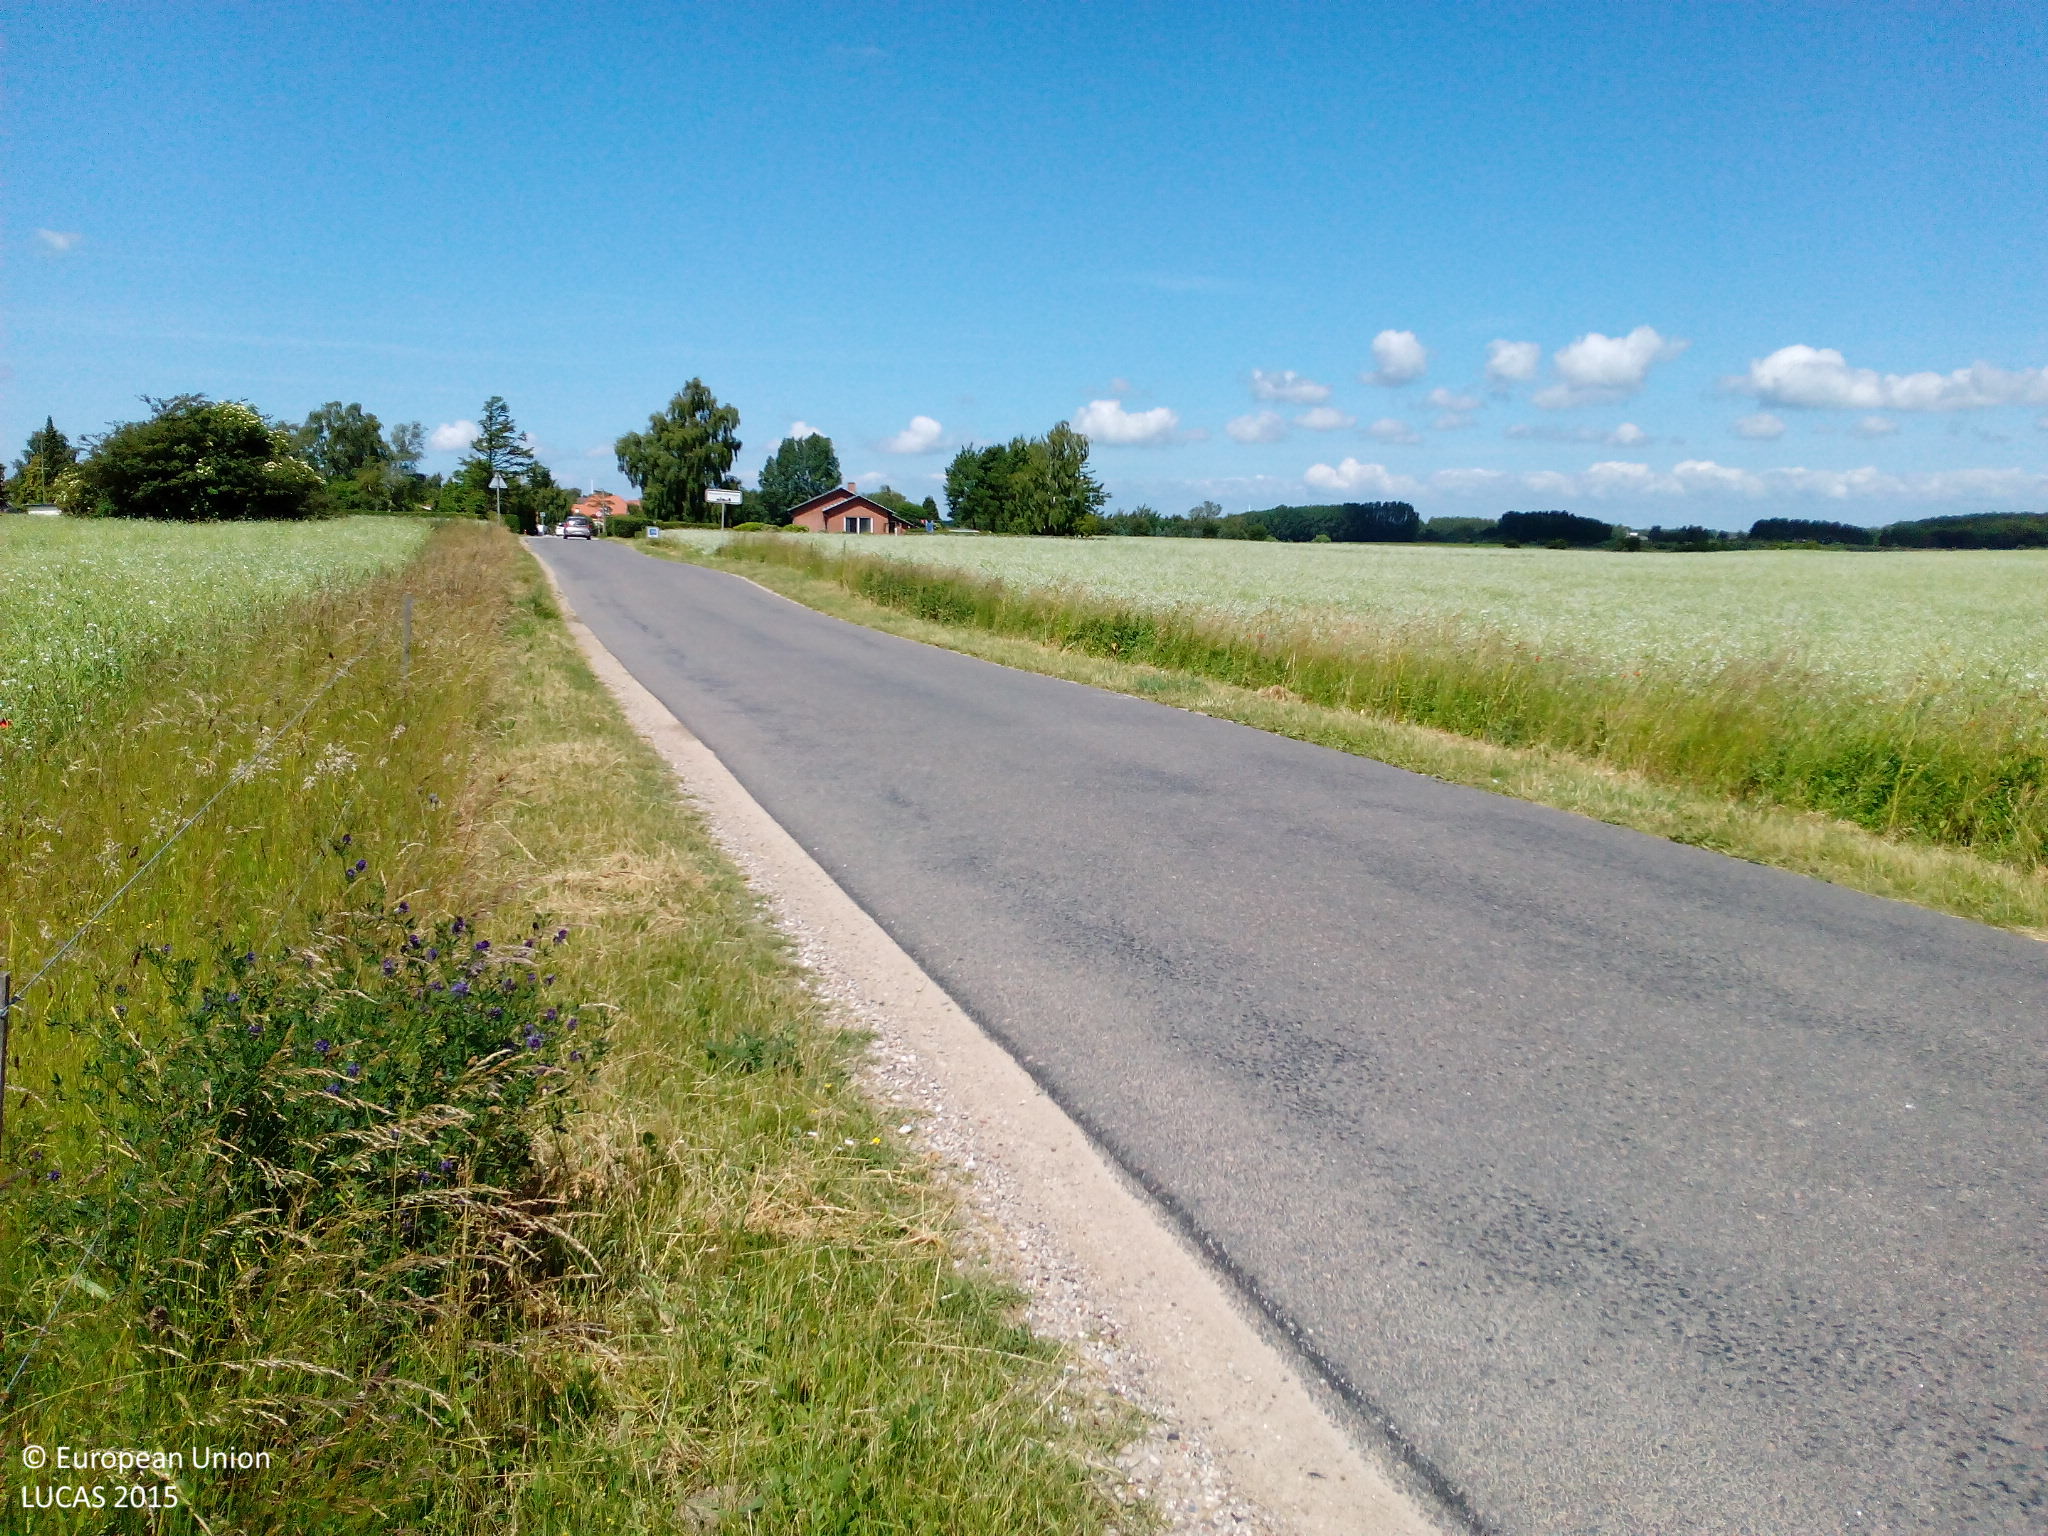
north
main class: Cropland
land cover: Dry pulses
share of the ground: > 75 %
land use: Agriculture (excluding fallow land and kitchen gardens)
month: June
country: DK
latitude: 54.7357
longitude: 11.8781
